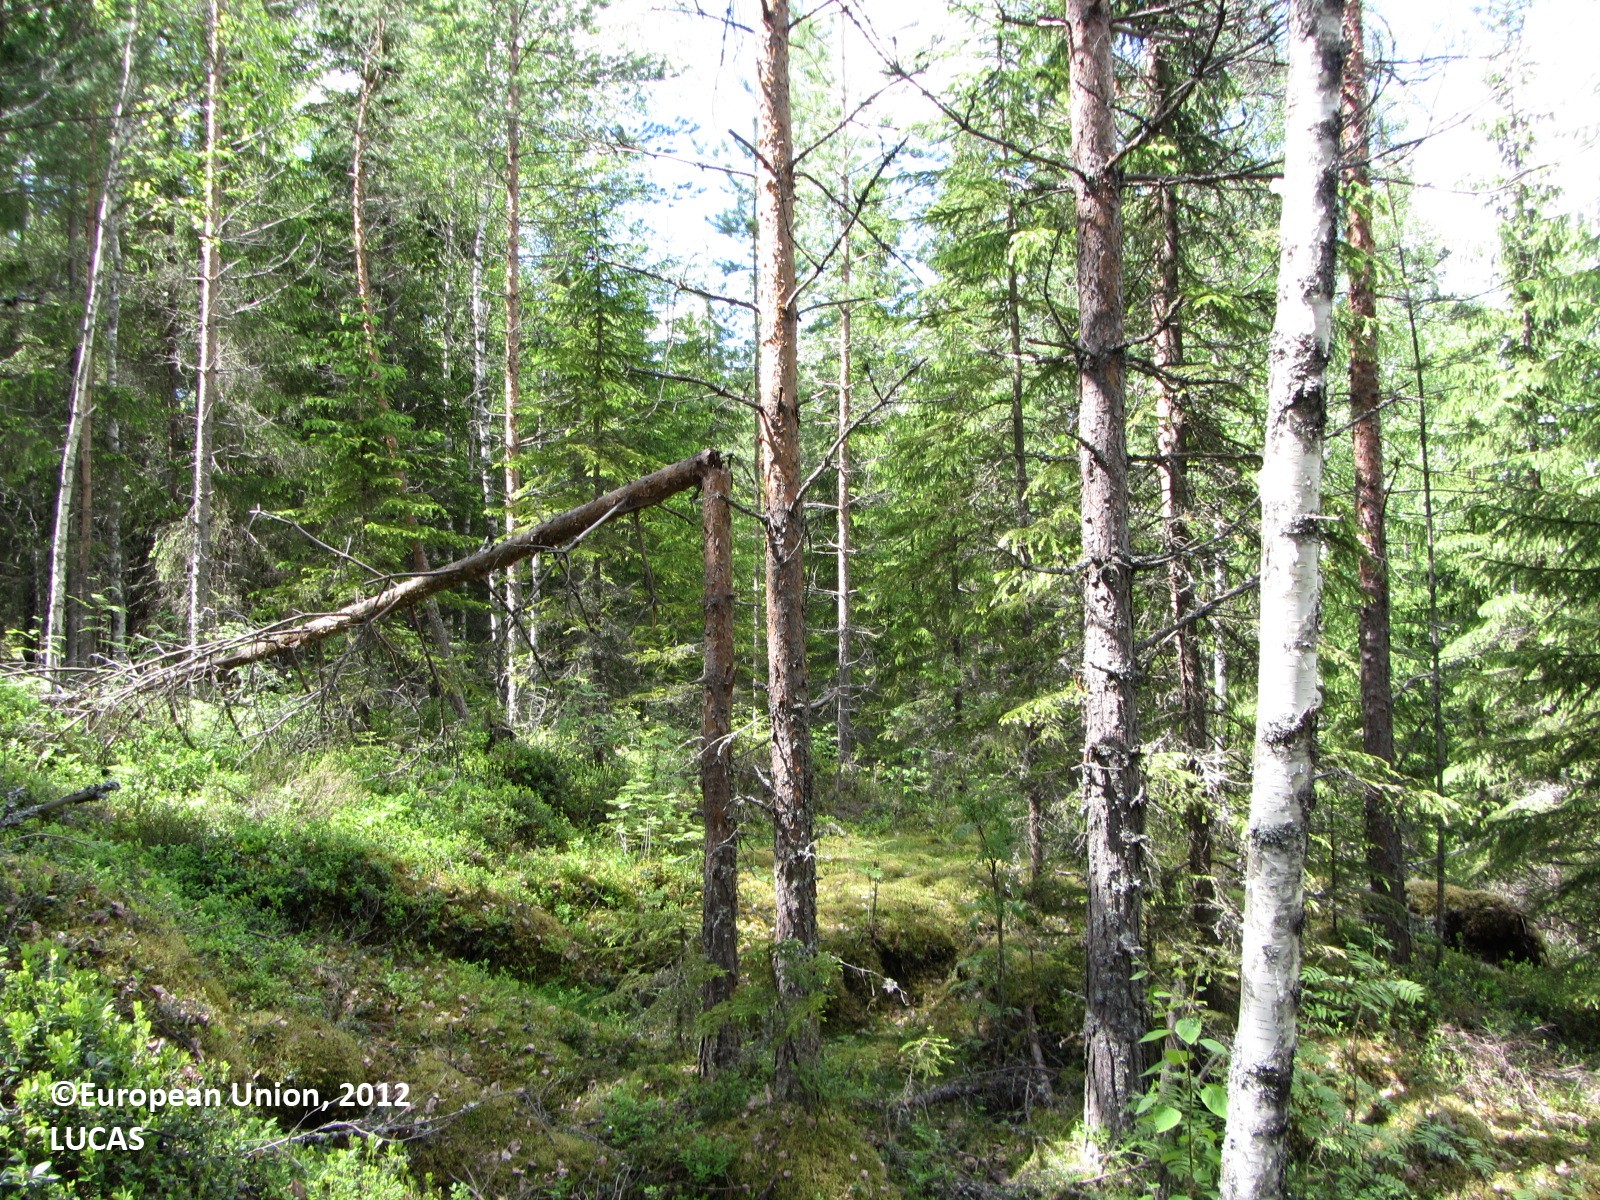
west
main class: Woodland
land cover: Pine dominated mixed woodland
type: boreal forest
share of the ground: > 75 %
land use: Forestry
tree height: > 5 m
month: June
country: FI
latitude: 61.9552
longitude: 24.9176
